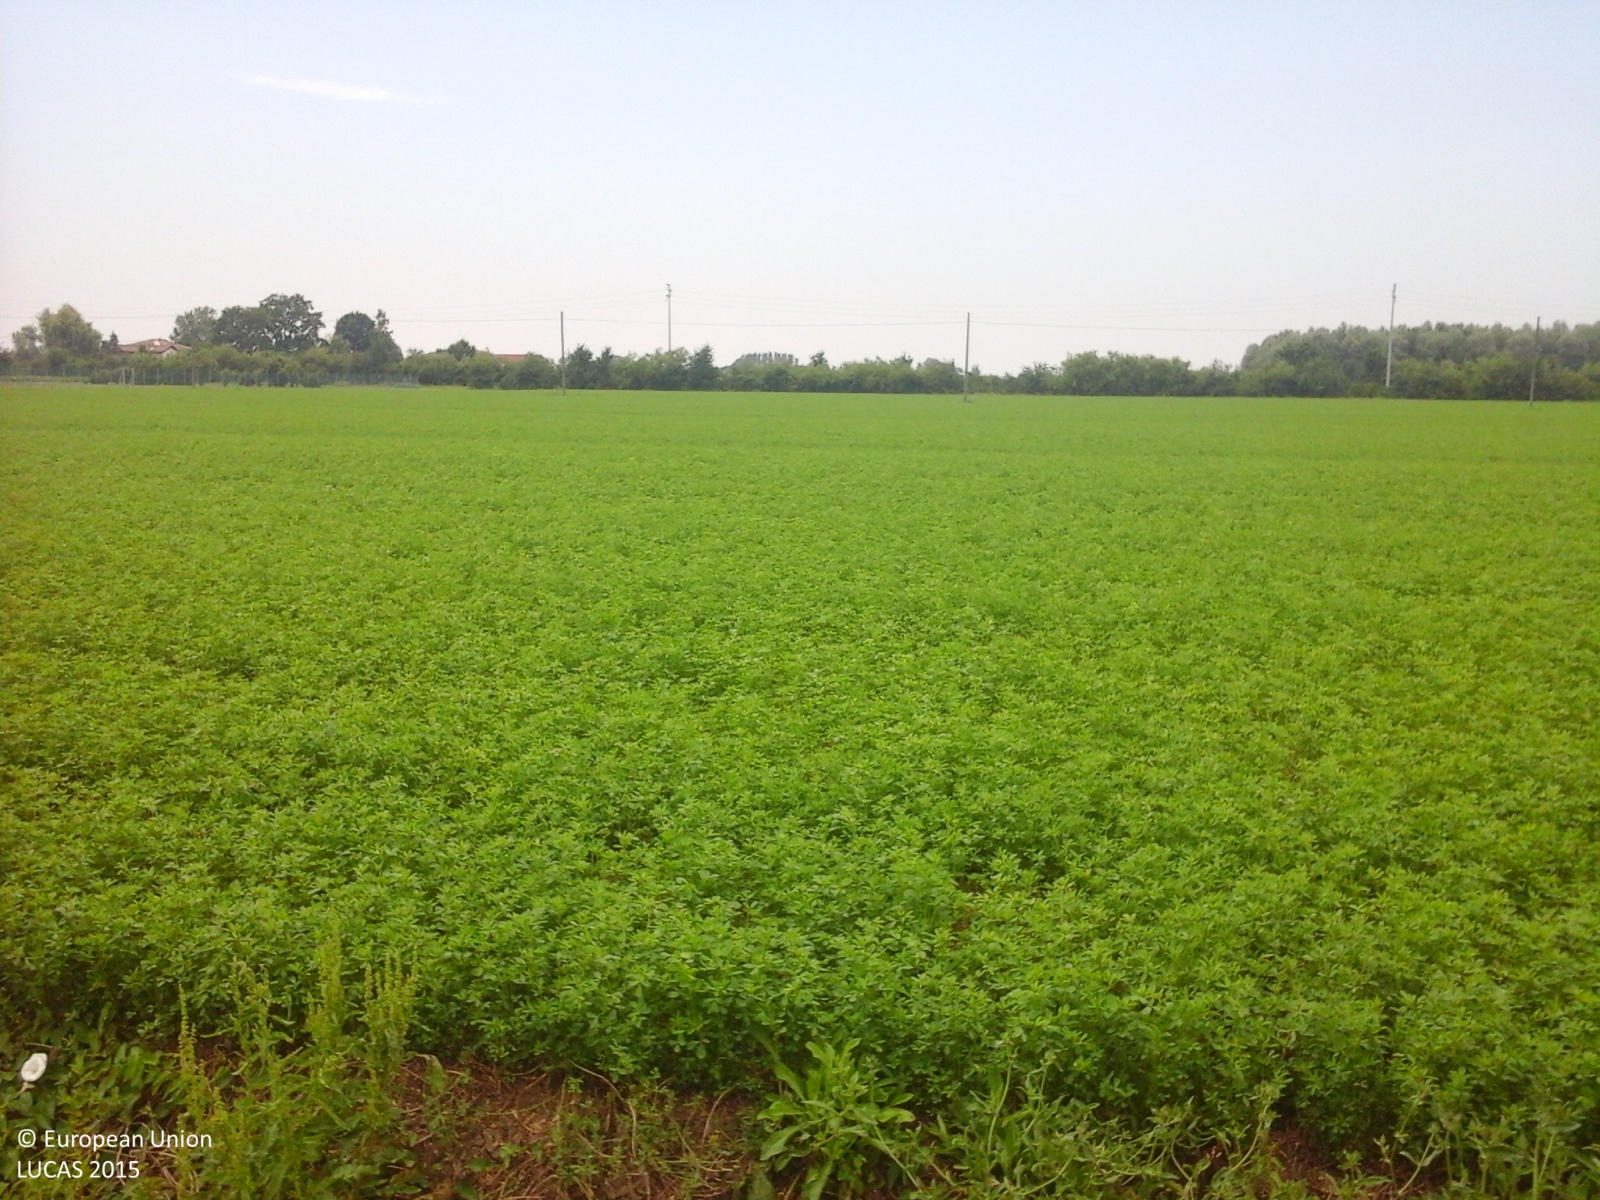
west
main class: Cropland
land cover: Lucerne
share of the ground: > 75 %
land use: Agriculture (excluding fallow land and kitchen gardens)
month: June
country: IT
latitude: 44.6151
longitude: 11.1192
